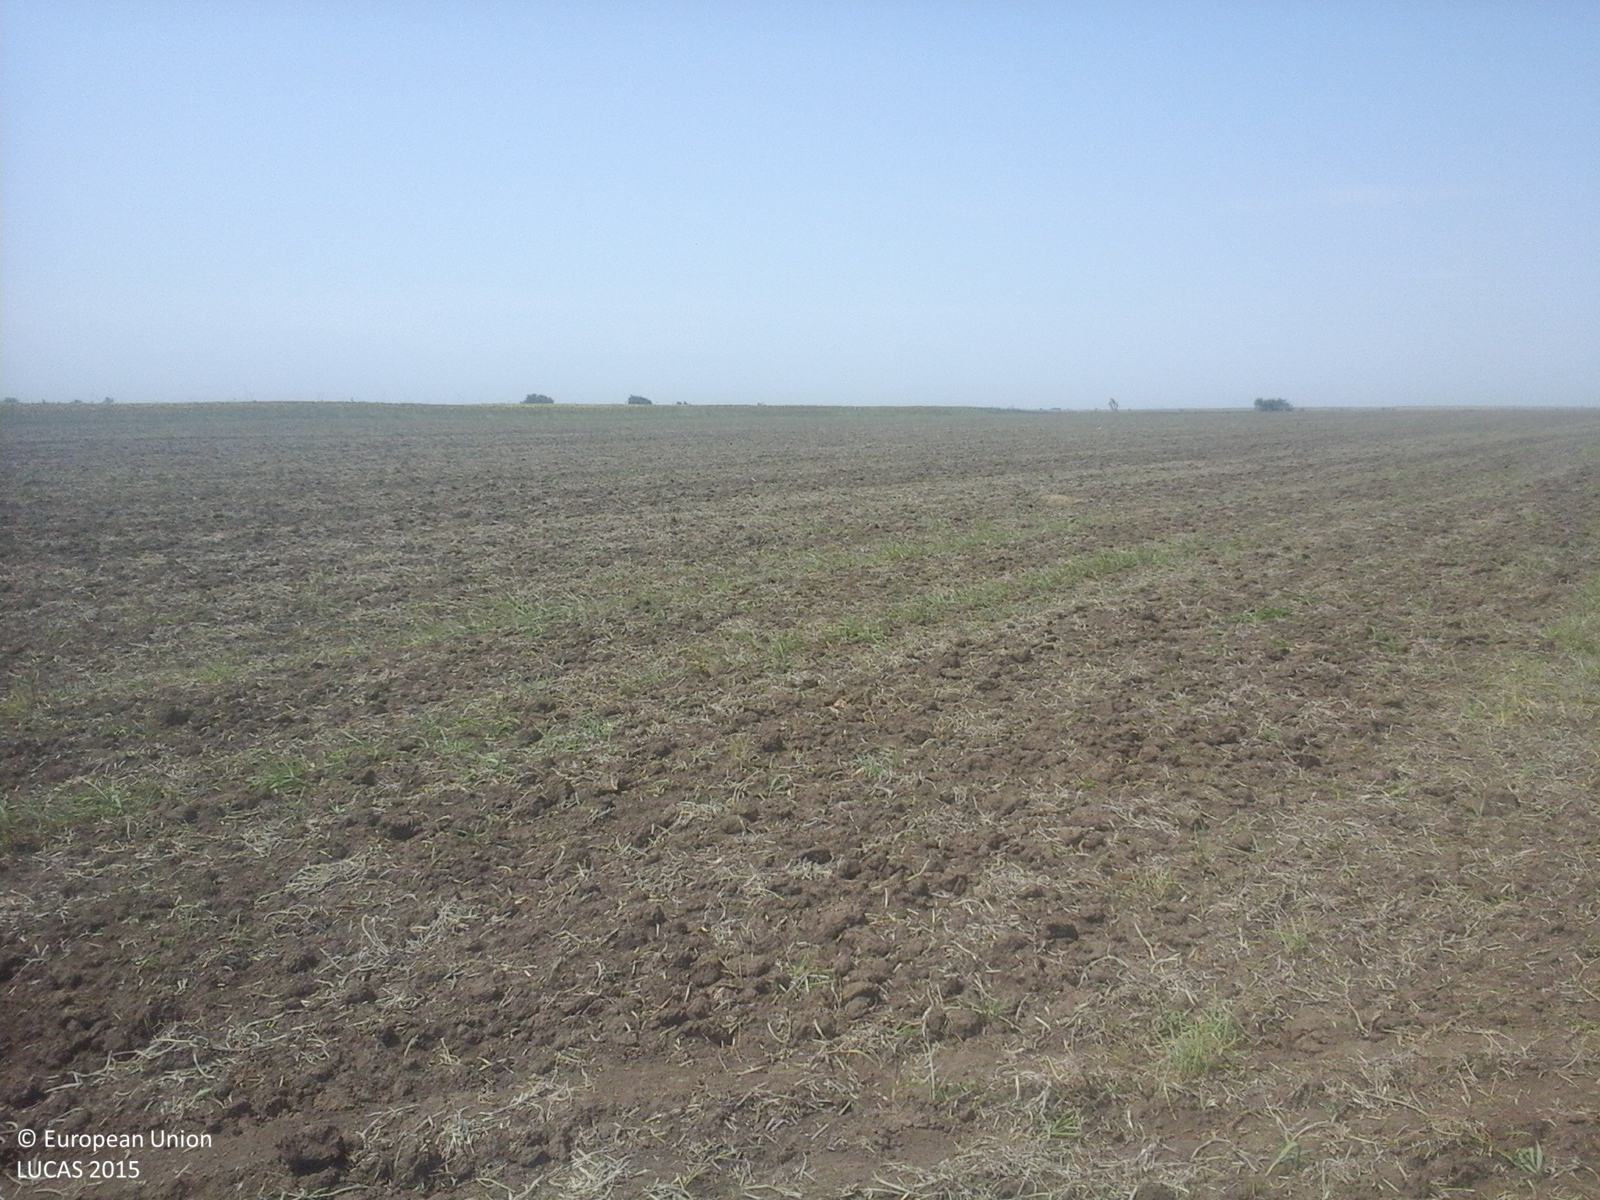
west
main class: Cropland
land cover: Soya
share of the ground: < 10 %
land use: Agriculture (excluding fallow land and kitchen gardens)
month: August
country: RO
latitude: 43.8882
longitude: 28.2956
